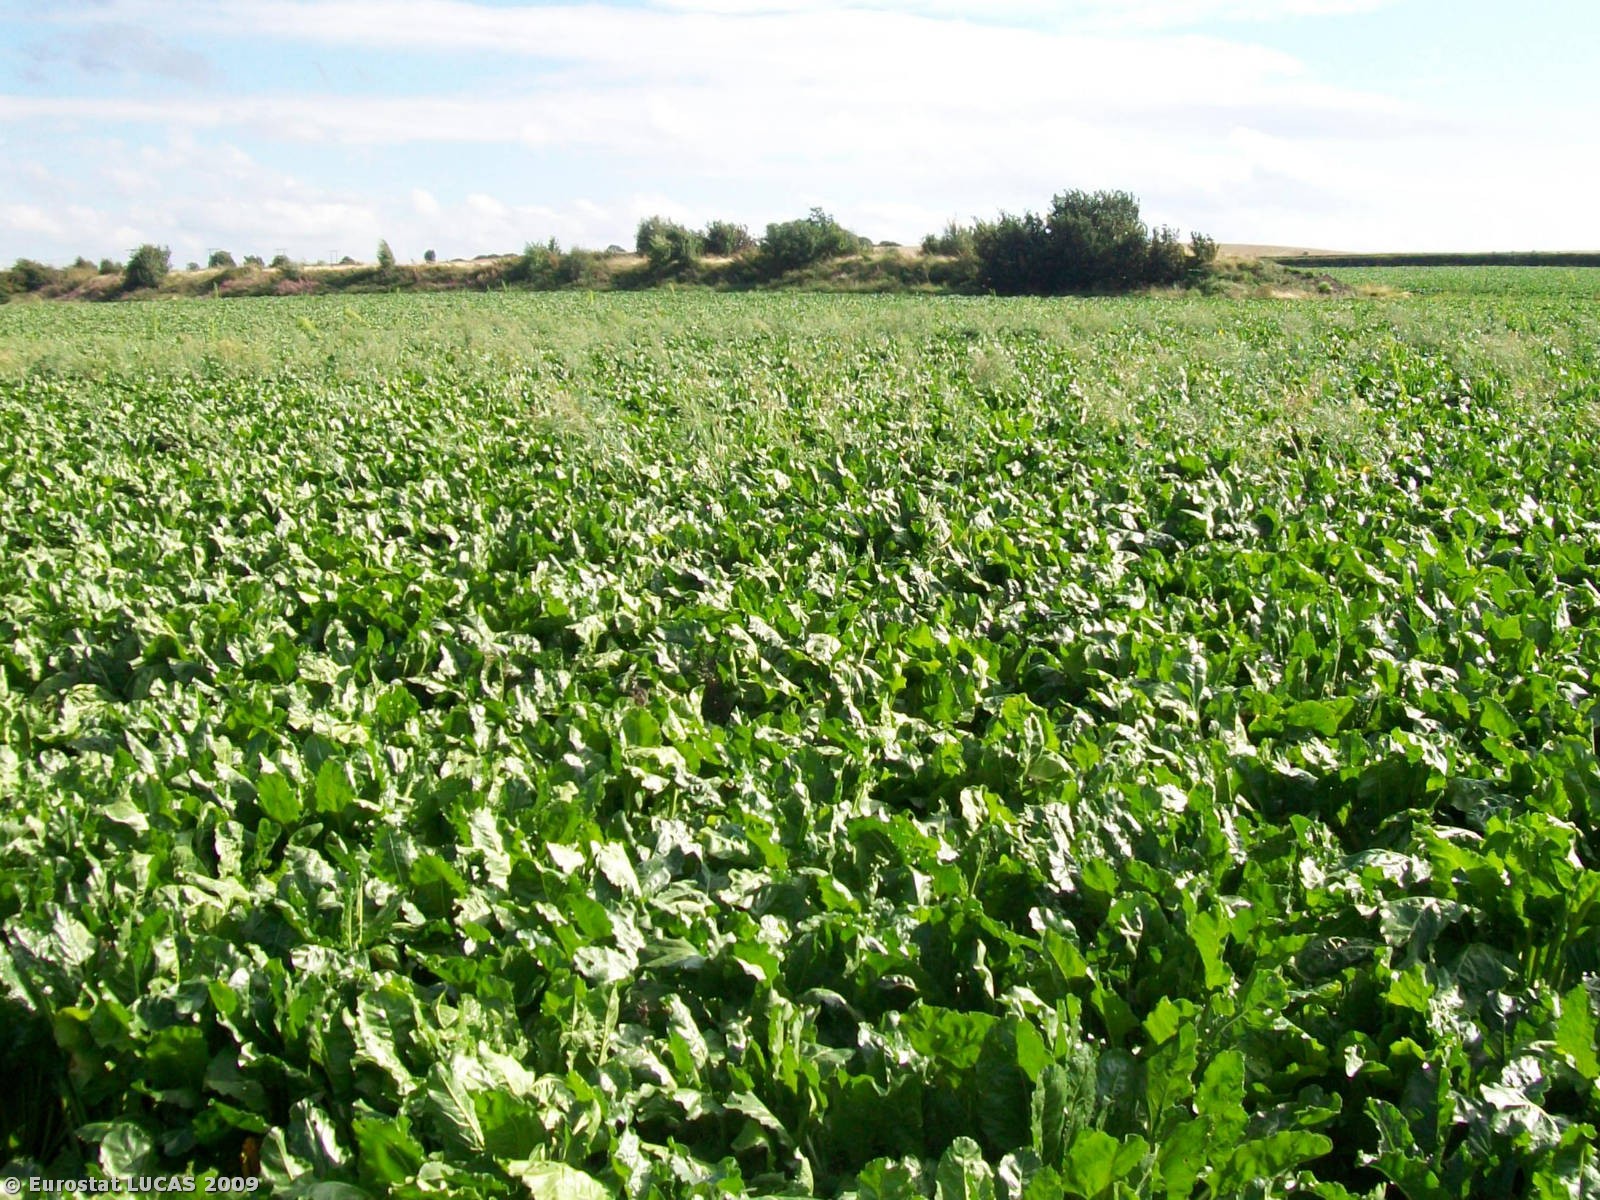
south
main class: Cropland
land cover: Other root crops
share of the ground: > 75 %
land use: Agriculture (excluding fallow land and kitchen gardens)
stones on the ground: 10 - 25 %
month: September
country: GB
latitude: 53.4554
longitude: -1.2664
